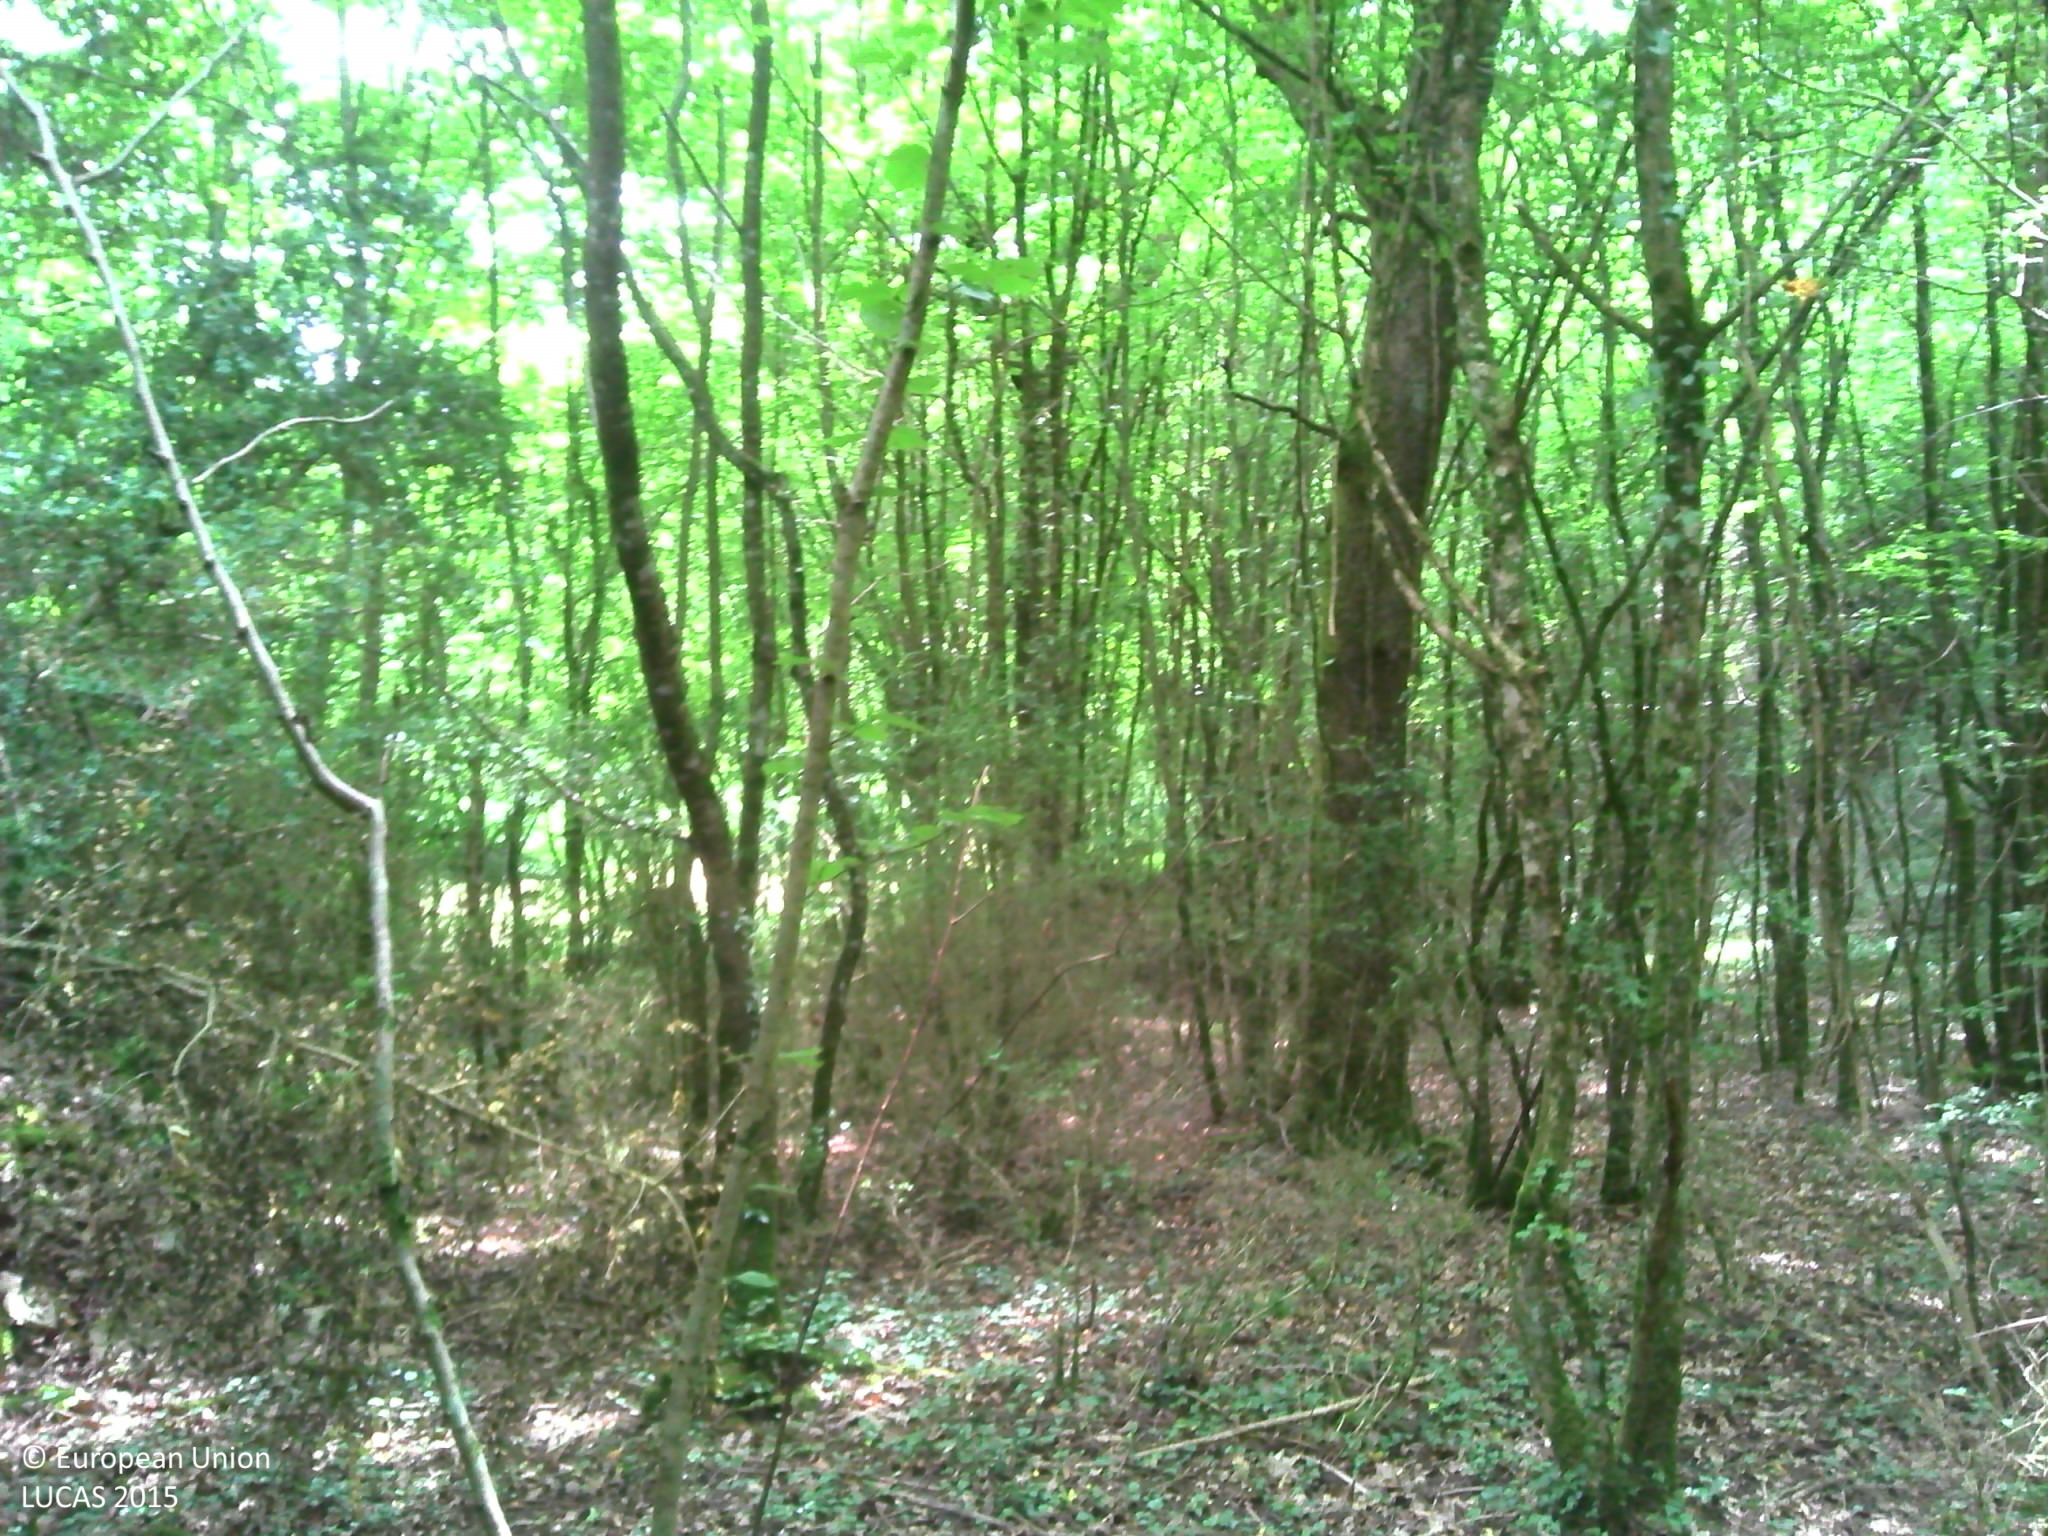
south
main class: Woodland
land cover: Broadleaved woodland
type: mesophytic deciduous forest
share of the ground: > 75 %
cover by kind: broadleaved forest trees 60 %, herbaceous plants 35 %, lichens and mosses 5 %
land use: Forestry
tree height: > 5 m
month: June
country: FR
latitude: 46.5687
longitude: 4.8222
